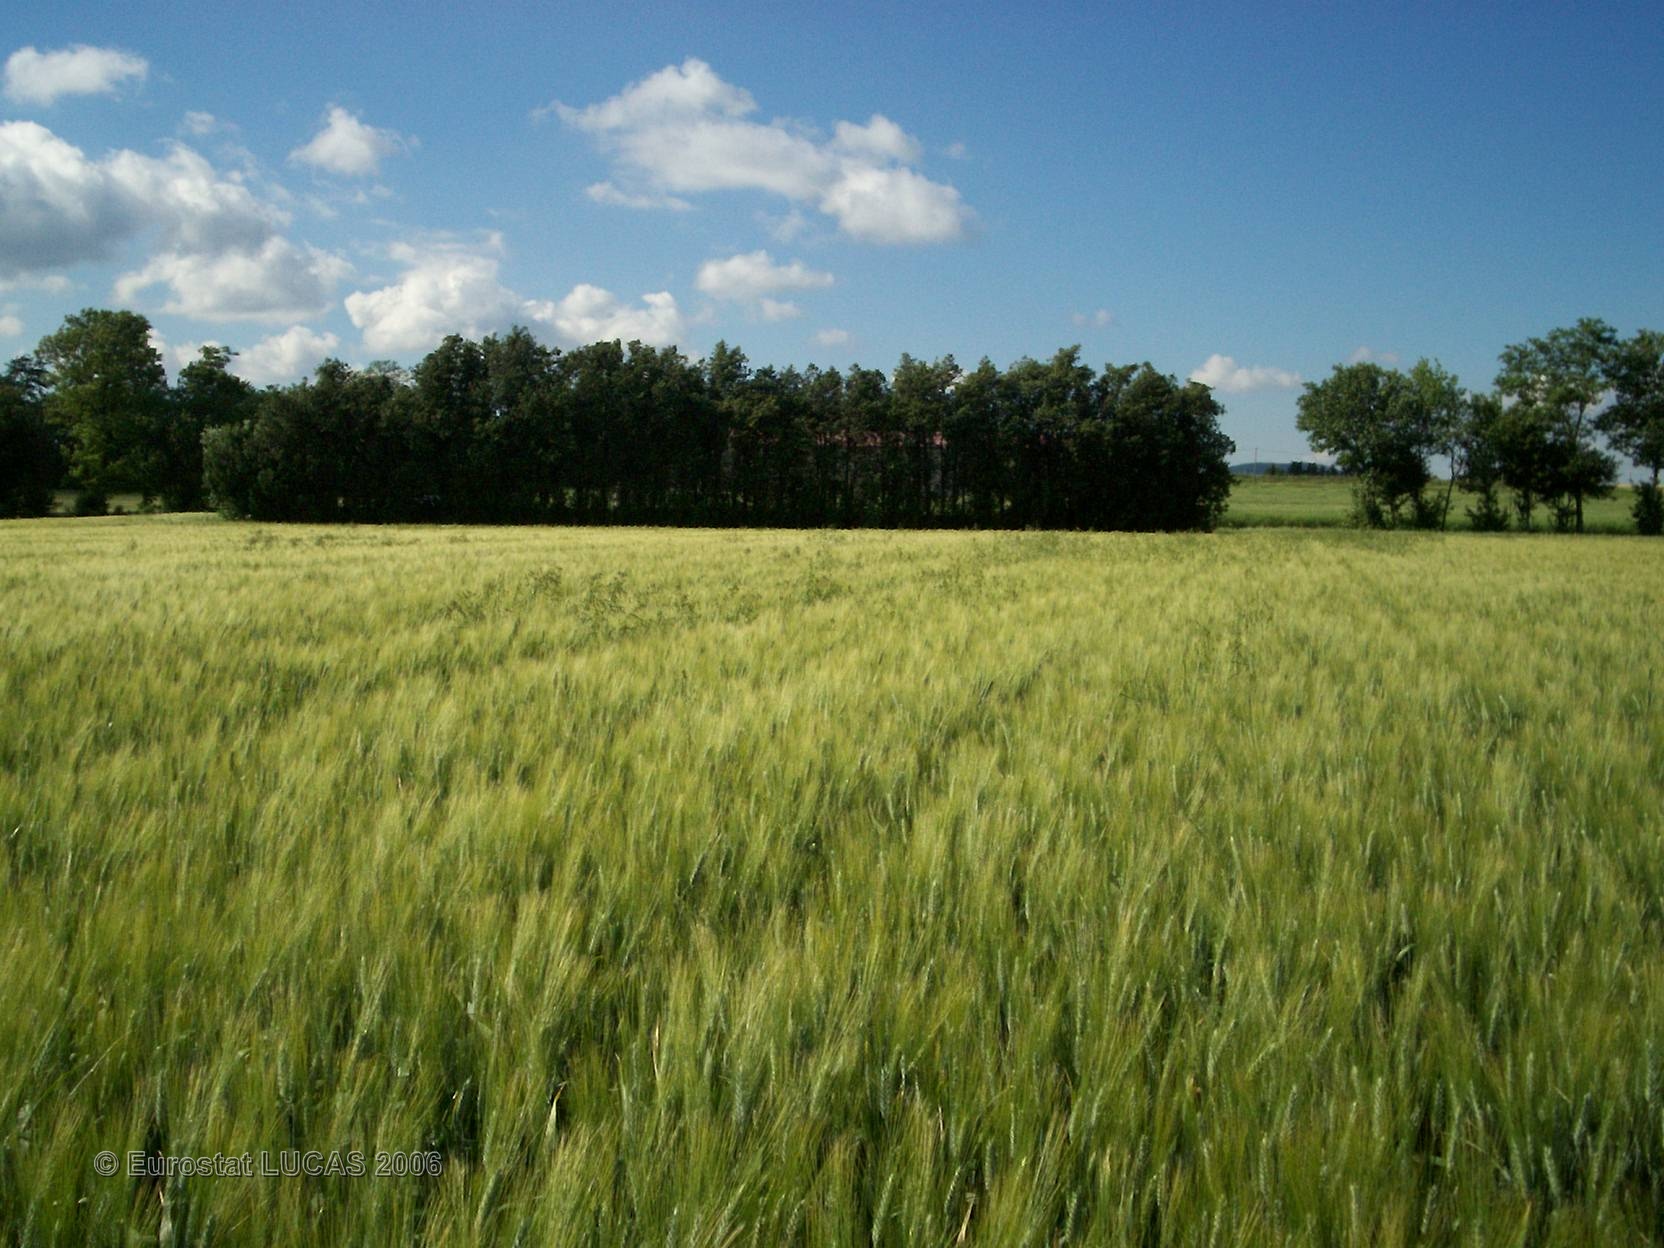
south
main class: Cropland
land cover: Durum wheat
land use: Agriculture (excluding fallow land and kitchen gardens)
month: May
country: FR
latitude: 44.5831
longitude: 4.8302
